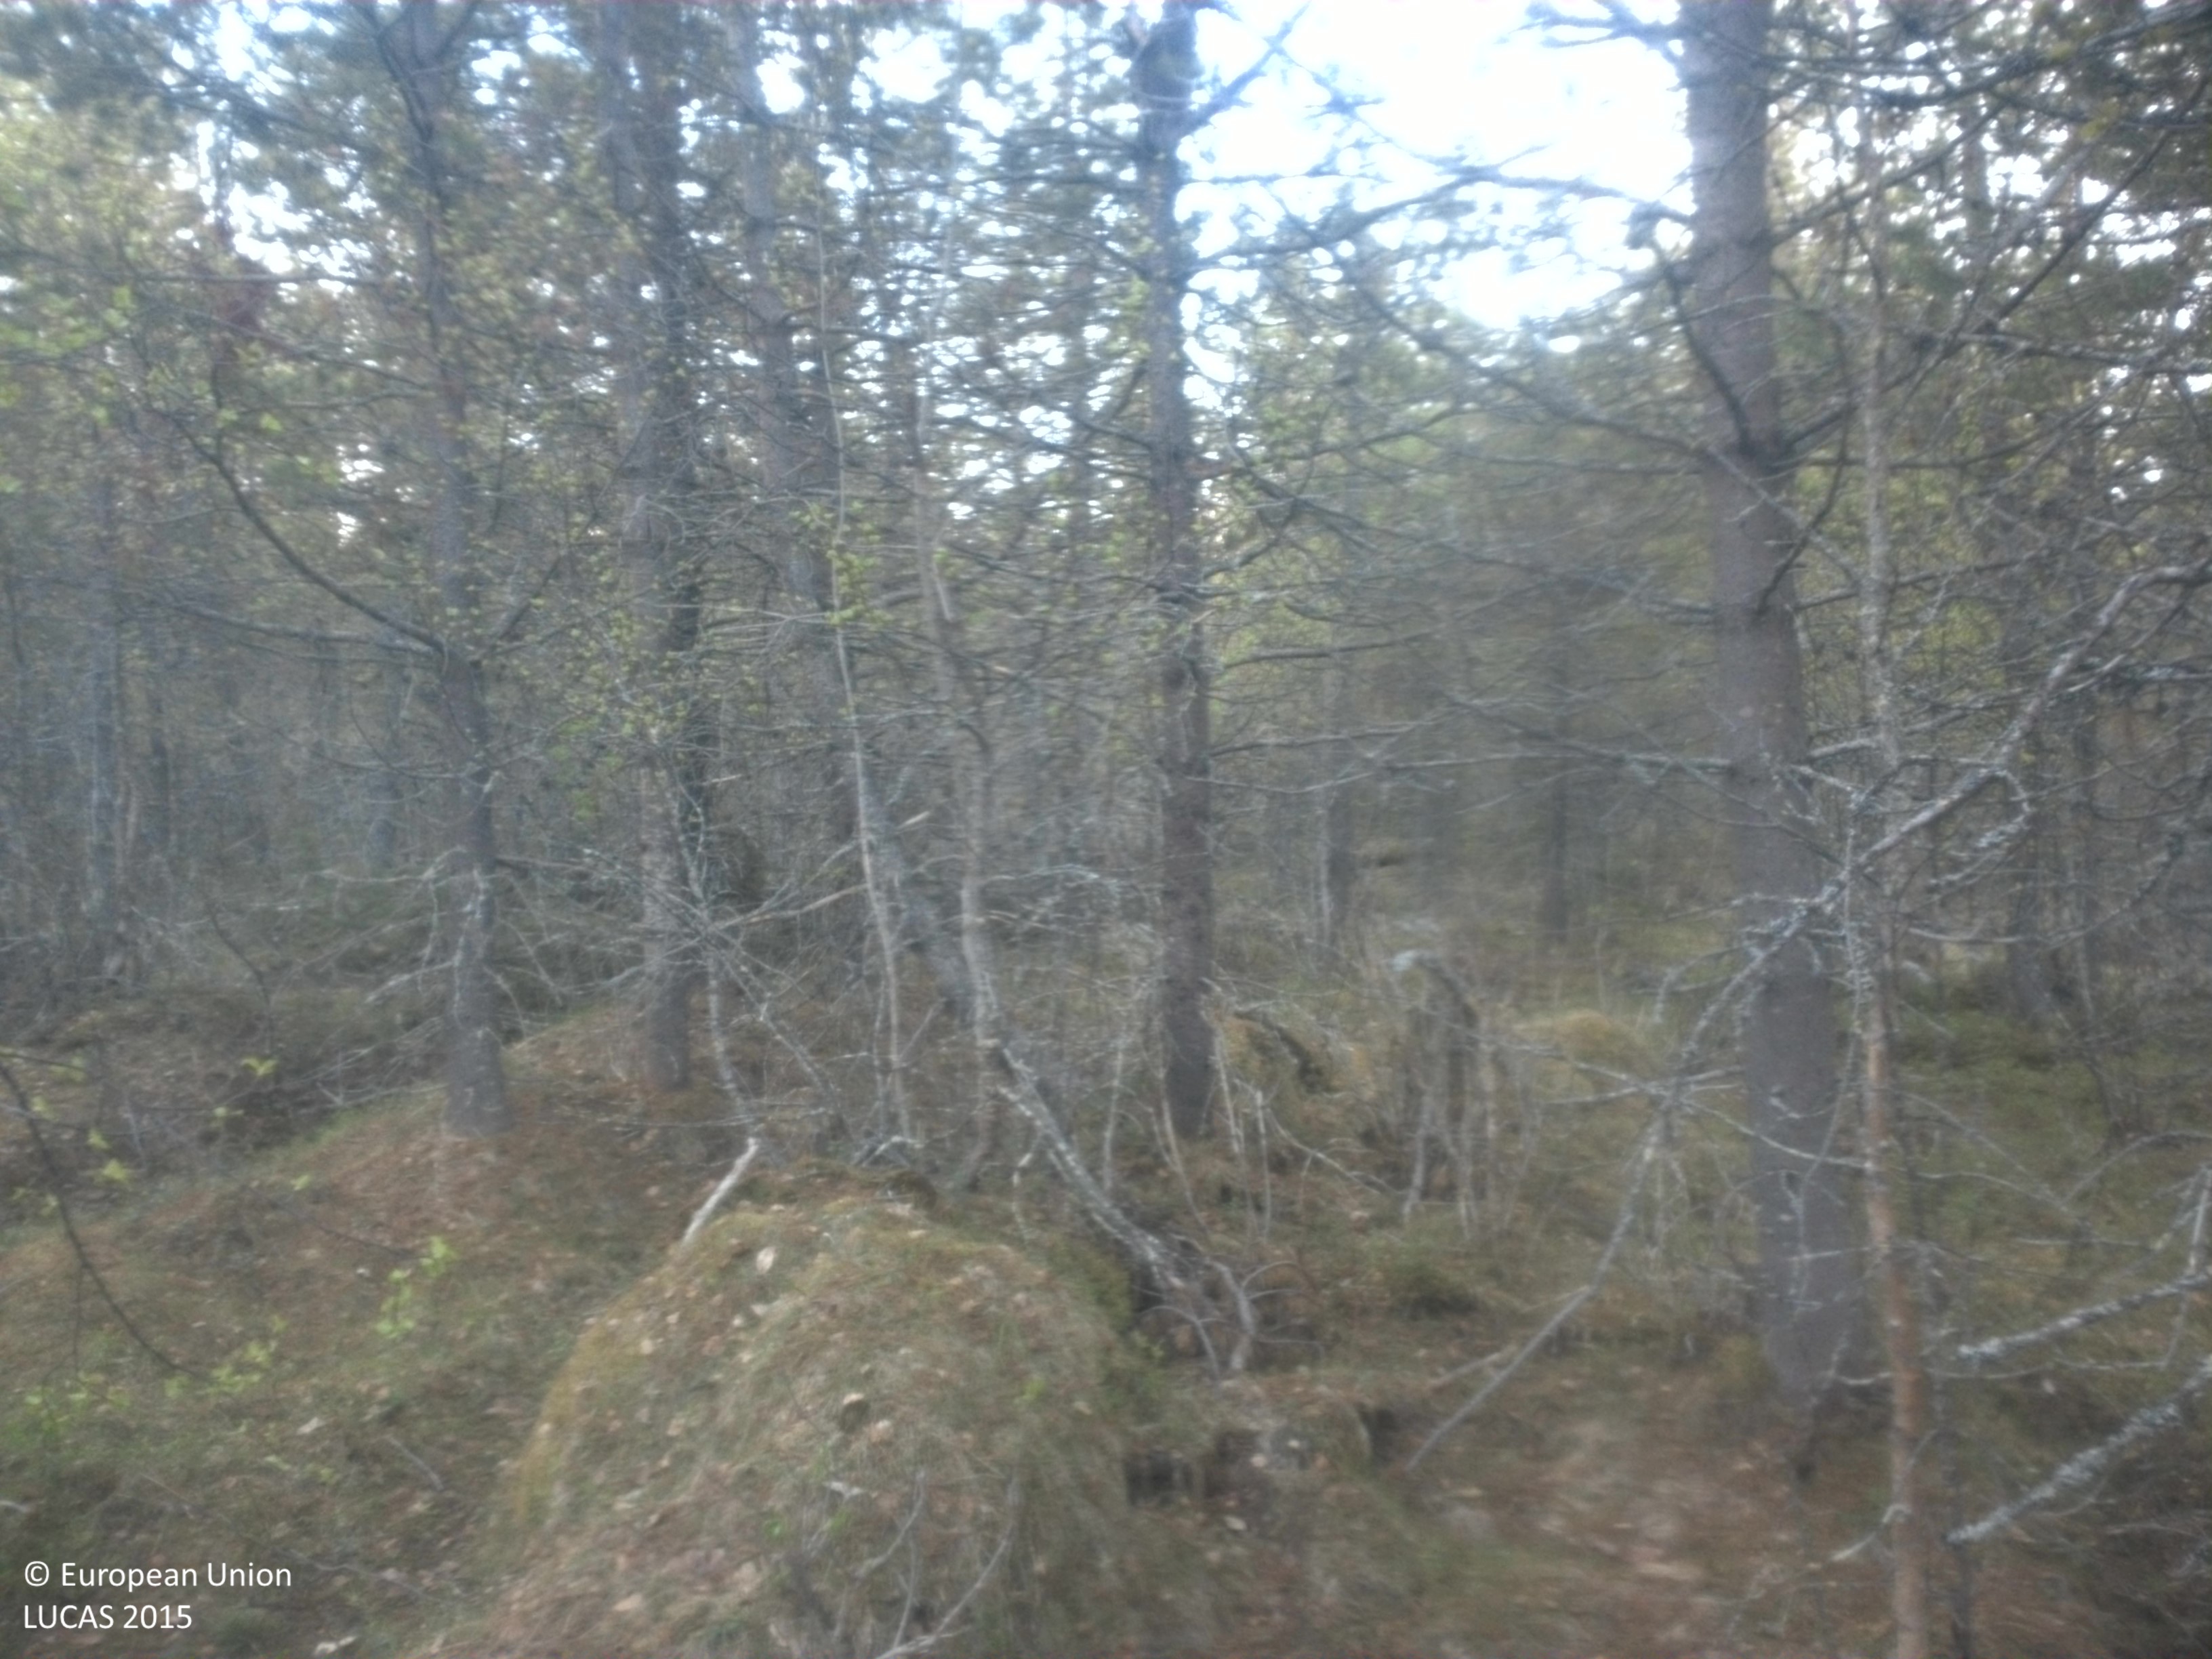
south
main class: Woodland
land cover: Pine dominated mixed woodland
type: exotic forest
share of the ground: 50 - 75 %
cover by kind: coniferous forest trees 45 %, herbaceous plants 20 %, broadleaved forest trees 15 %, lichens and mosses 10 %, shrubs 5 %, unconsolidated bare surface 5 %
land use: Forestry
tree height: > 5 m
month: June
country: SE
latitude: 64.4981
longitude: 17.7737
